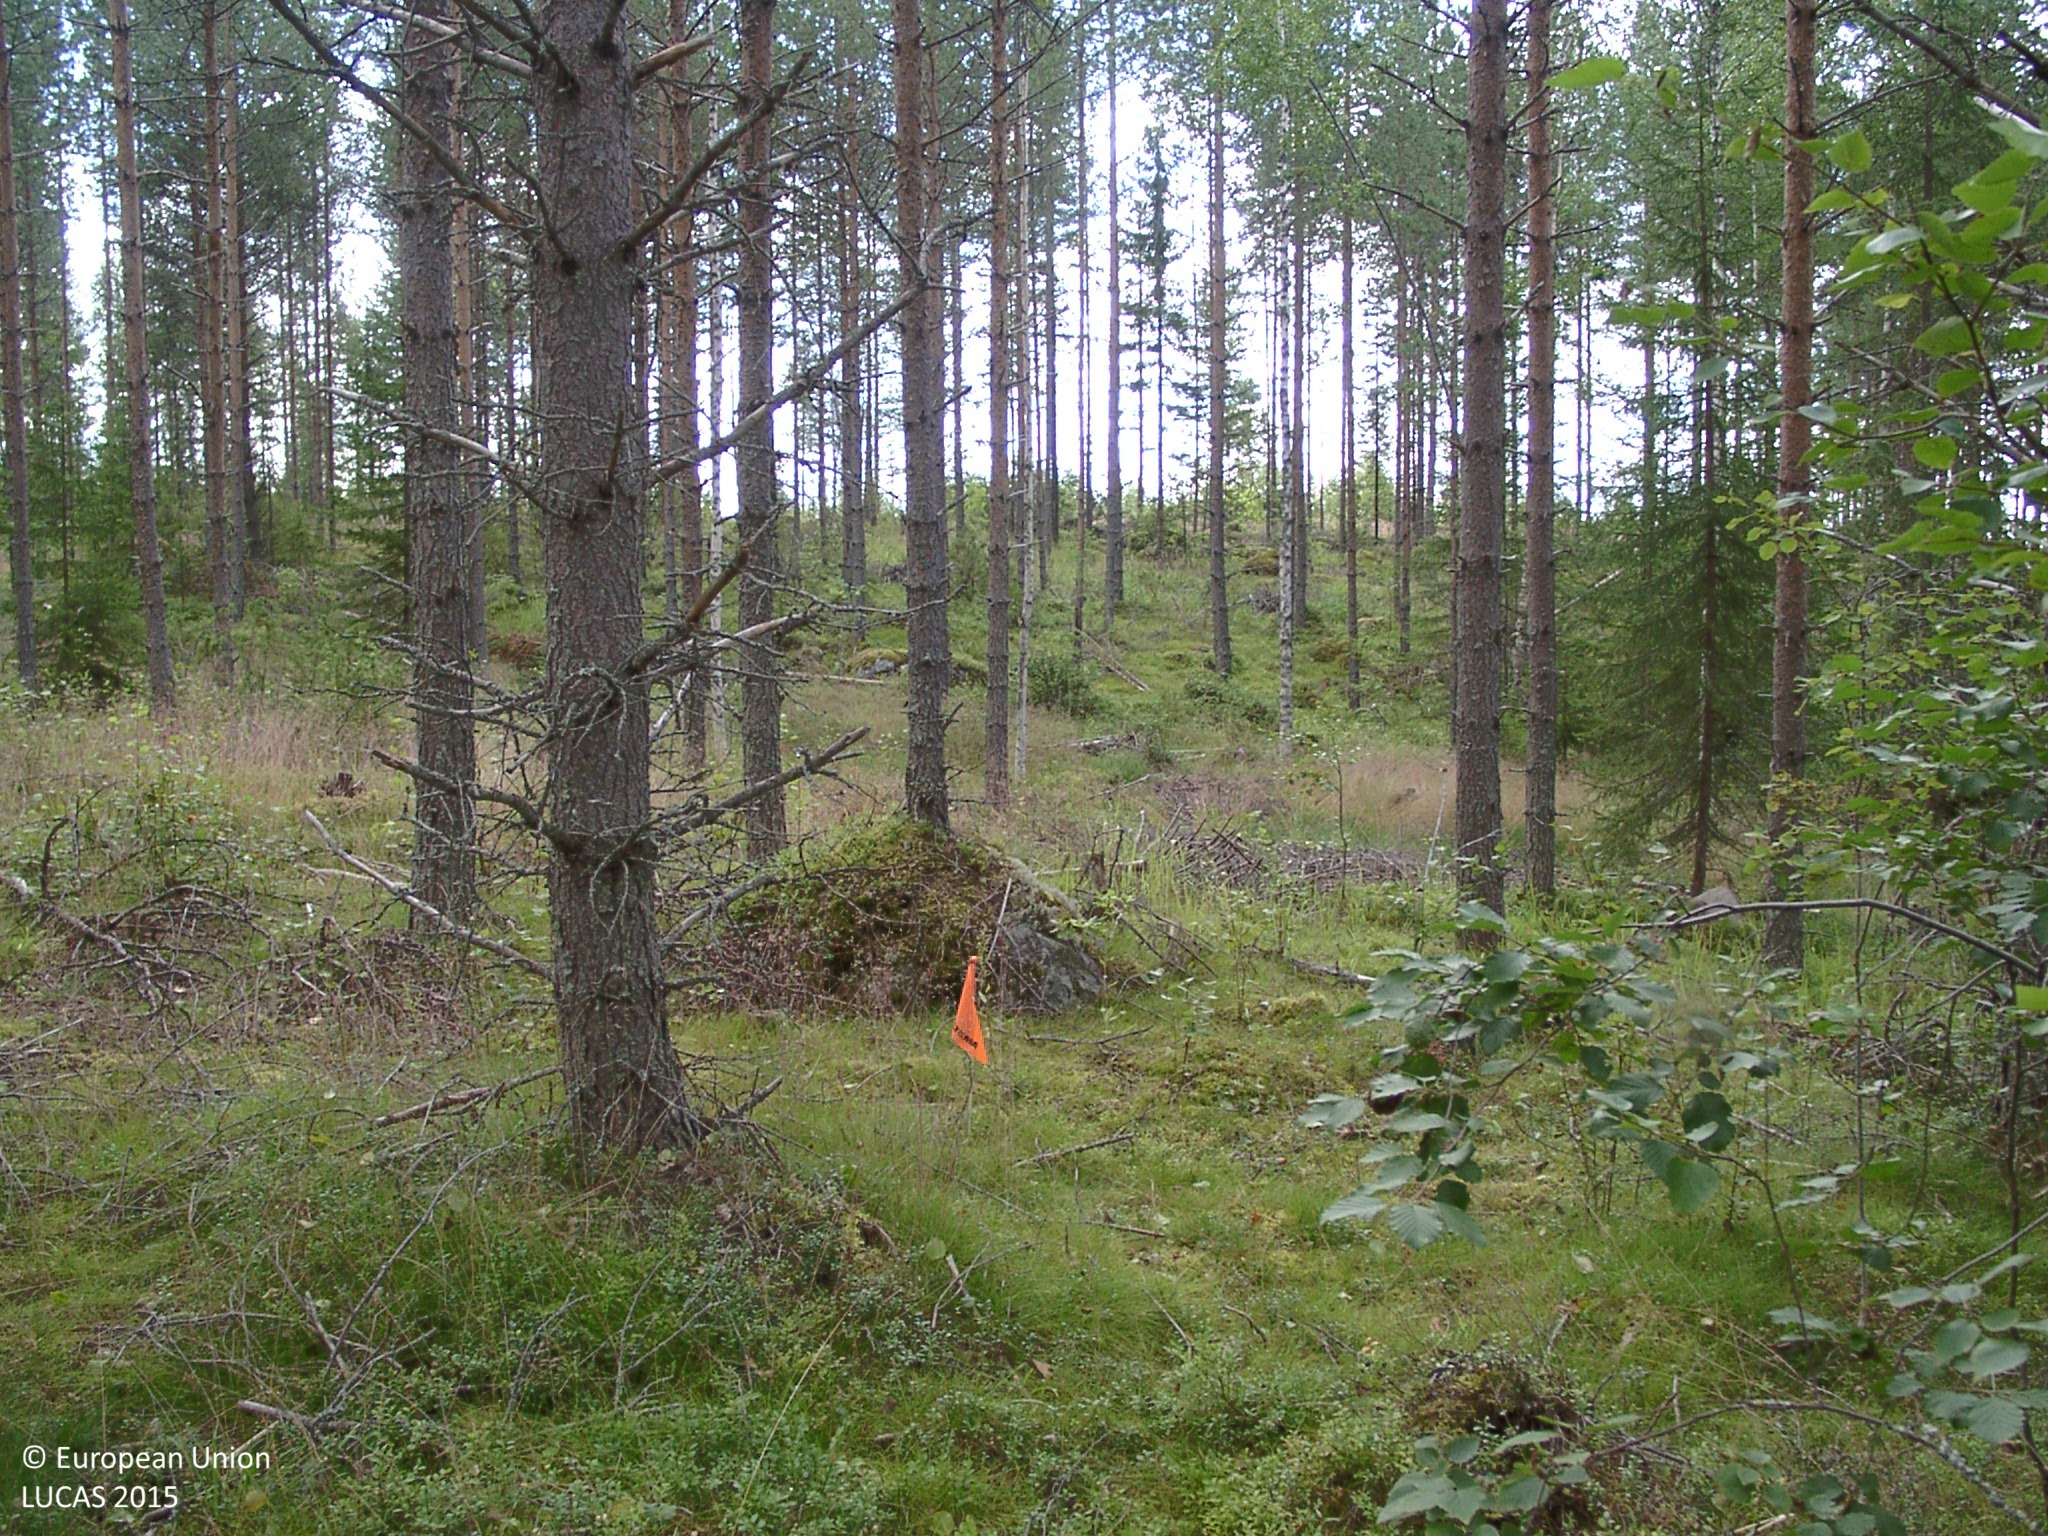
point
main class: Woodland
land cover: Pine dominated coniferous woodland
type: boreal forest
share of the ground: 50 - 75 %
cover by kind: coniferous forest trees 60 %, shrubs 10 %, herbaceous plants 10 %, lichens and mosses 10 %, broadleaved forest trees 5 %
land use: Forestry
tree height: > 5 m
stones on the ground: < 10 %
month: August
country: FI
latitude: 62.3331
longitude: 25.5389
